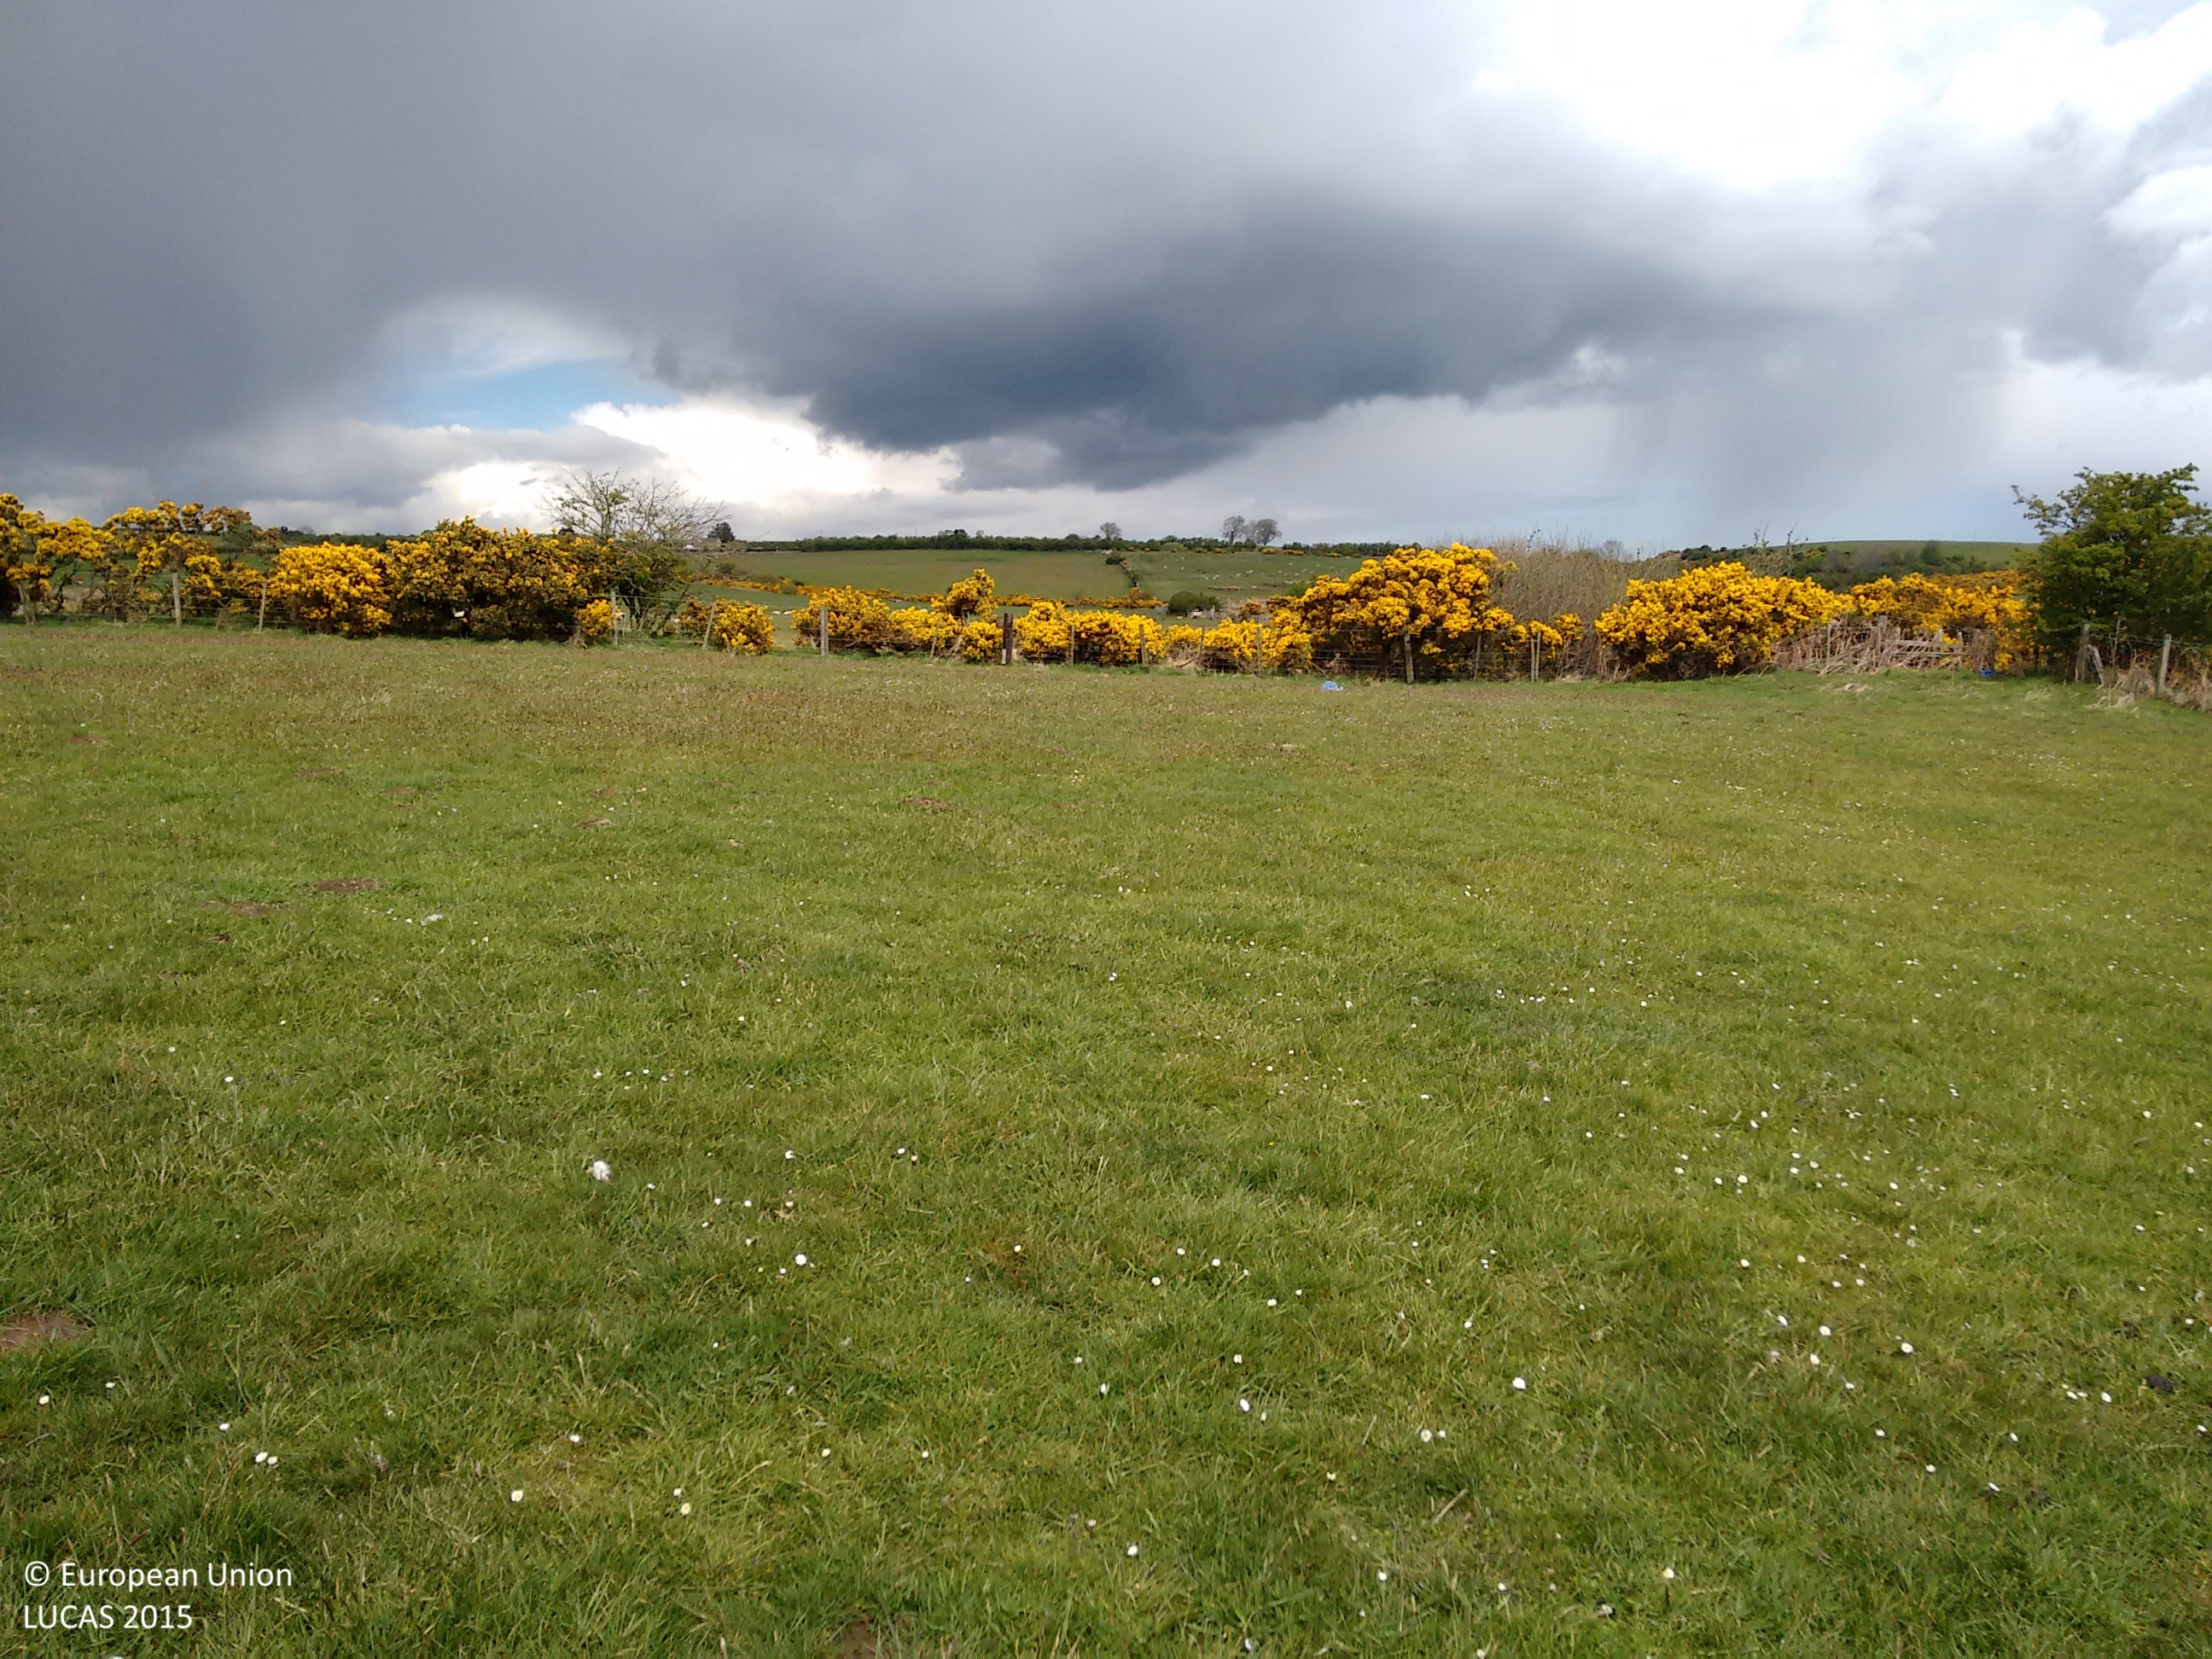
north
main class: Grassland
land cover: Grassland without tree/shrub cover
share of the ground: > 75 %
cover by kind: herbaceous plants 100 %
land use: Agriculture (excluding fallow land and kitchen gardens)
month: May
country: GB
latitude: 55.3913
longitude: -1.7480
